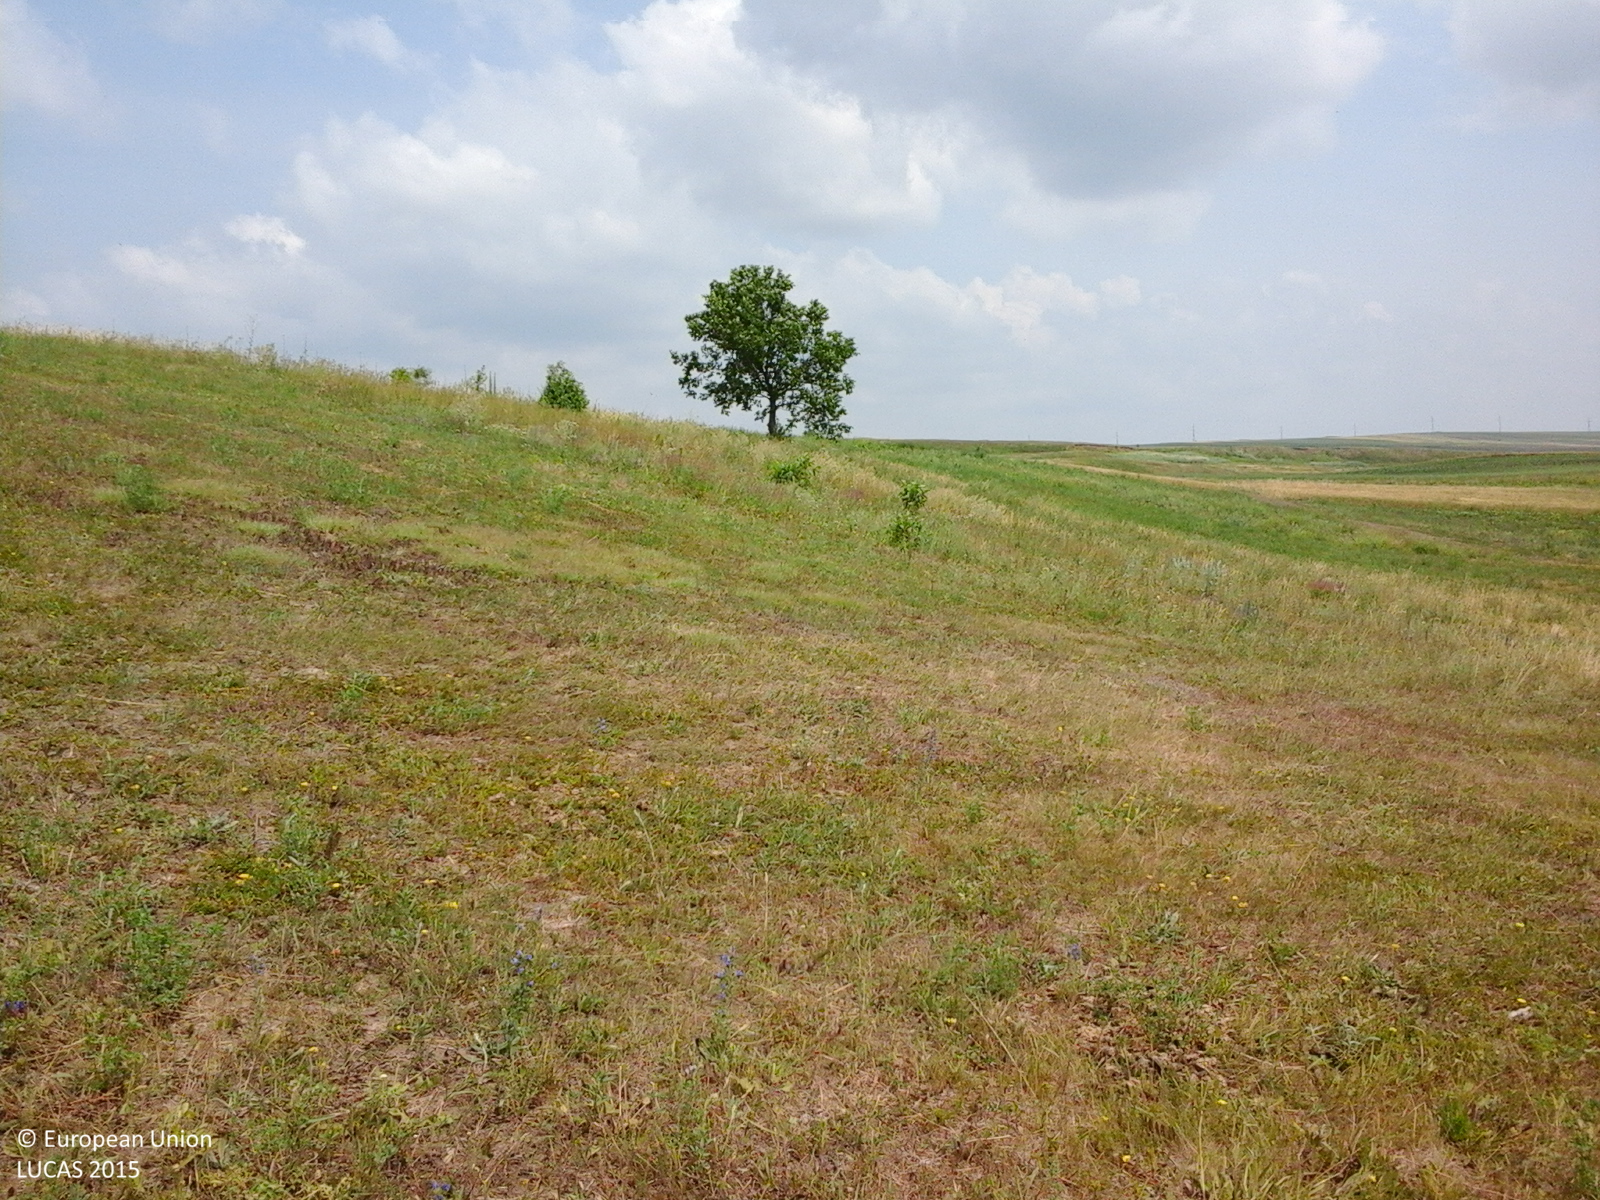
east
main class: Grassland
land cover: Grassland without tree/shrub cover
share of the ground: > 75 %
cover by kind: herbaceous plants 100 %
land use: Agriculture (excluding fallow land and kitchen gardens)
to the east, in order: Grassland without tree/shrub cover; Lucerne; Single bushes/trees; Lucerne; Soya; Common wheat; Spontaneously vegetated surfaces; Soya; Grassland without tree/shrub cover
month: June
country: RO
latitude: 48.0590
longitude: 26.6958
